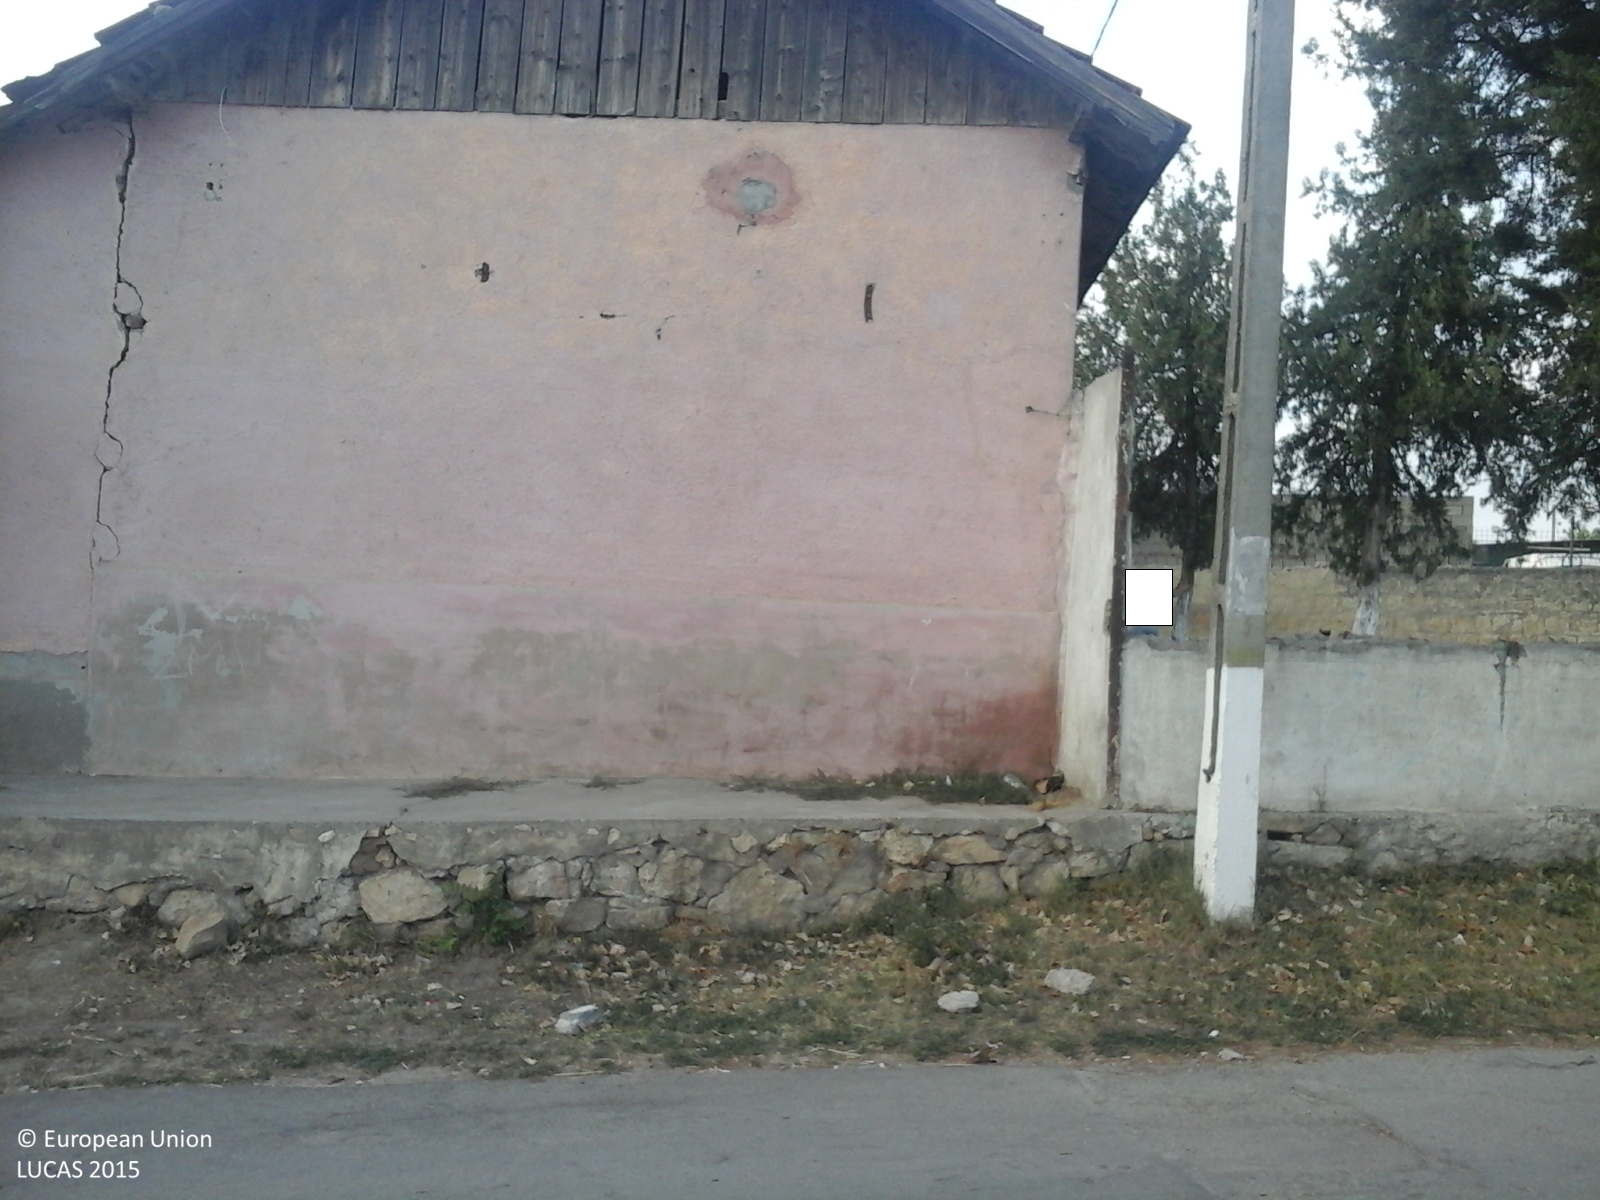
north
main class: Grassland
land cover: Grassland with sparse tree/shrub cover
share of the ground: > 75 %
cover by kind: herbaceous plants 85 %, shrubs 10 %, broadleaved forest trees 5 %
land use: Community services
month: August
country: RO
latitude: 44.3719
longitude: 28.0666
